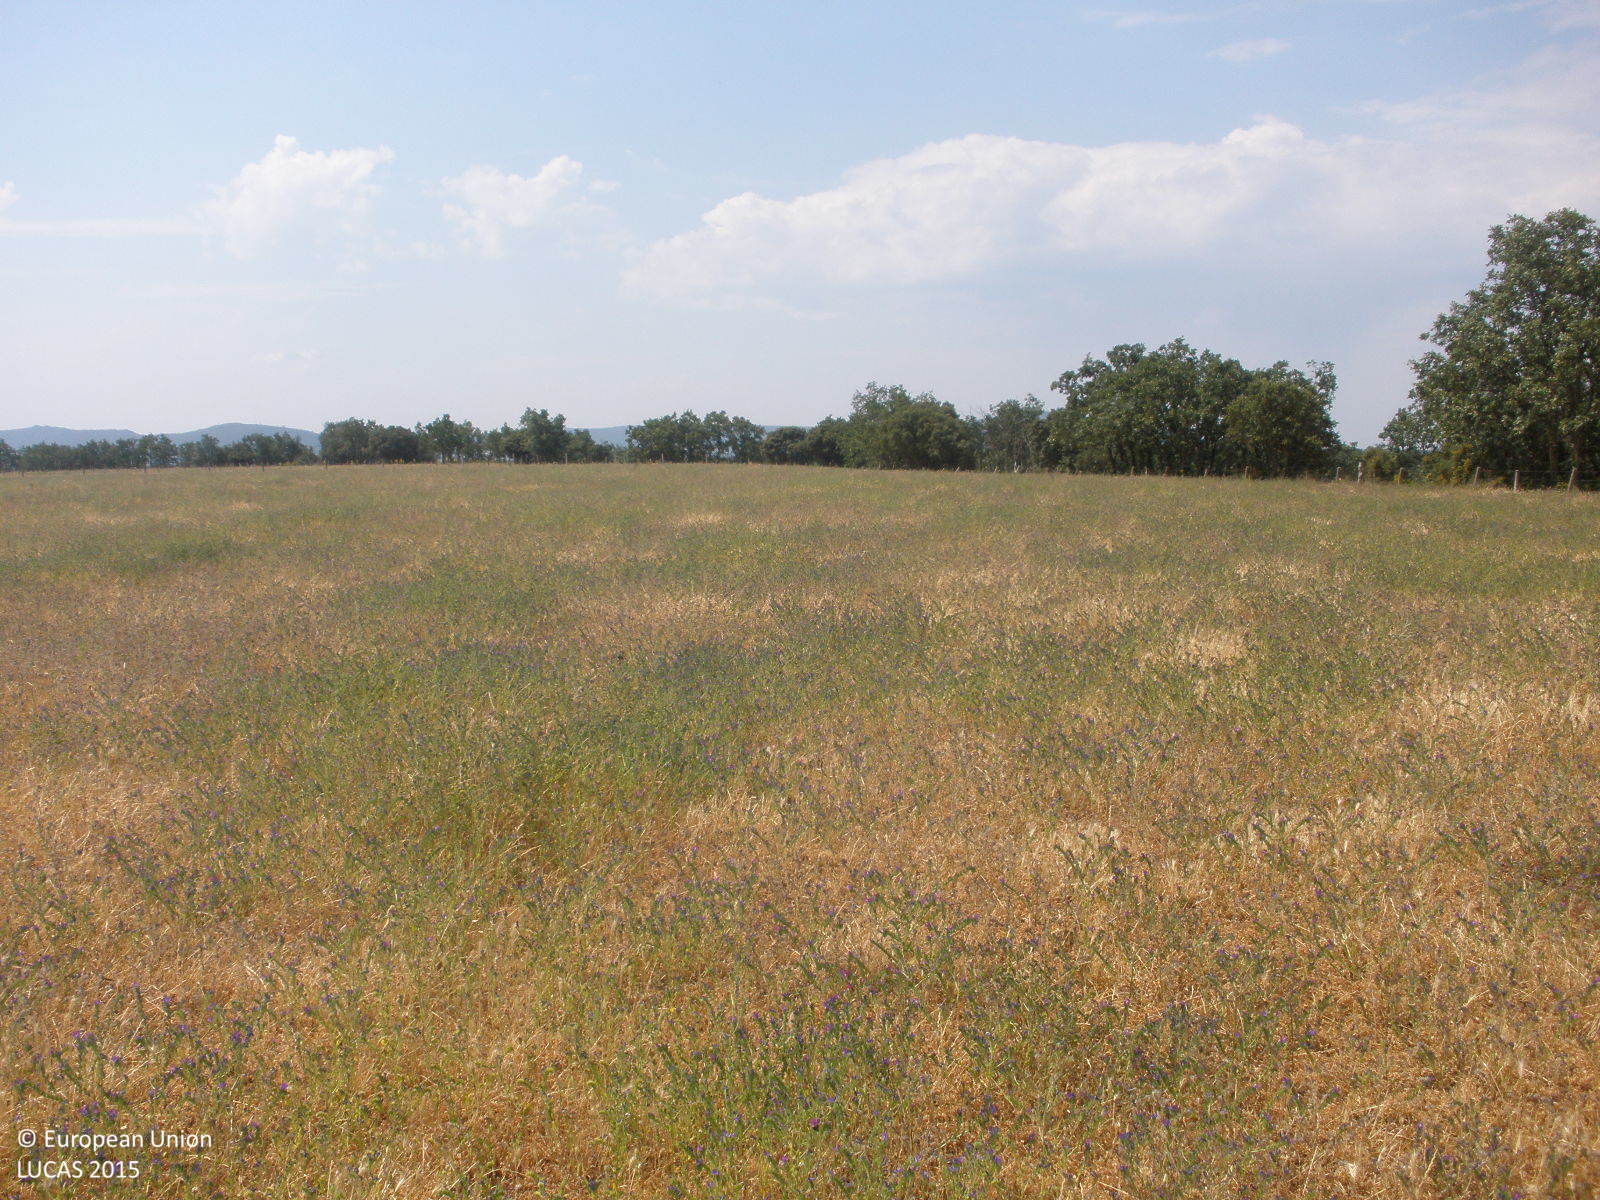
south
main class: Grassland
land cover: Grassland without tree/shrub cover
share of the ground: > 75 %
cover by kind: herbaceous plants 100 %
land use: Agriculture (excluding fallow land and kitchen gardens)
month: June
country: ES
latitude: 40.6314
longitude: -6.3668
